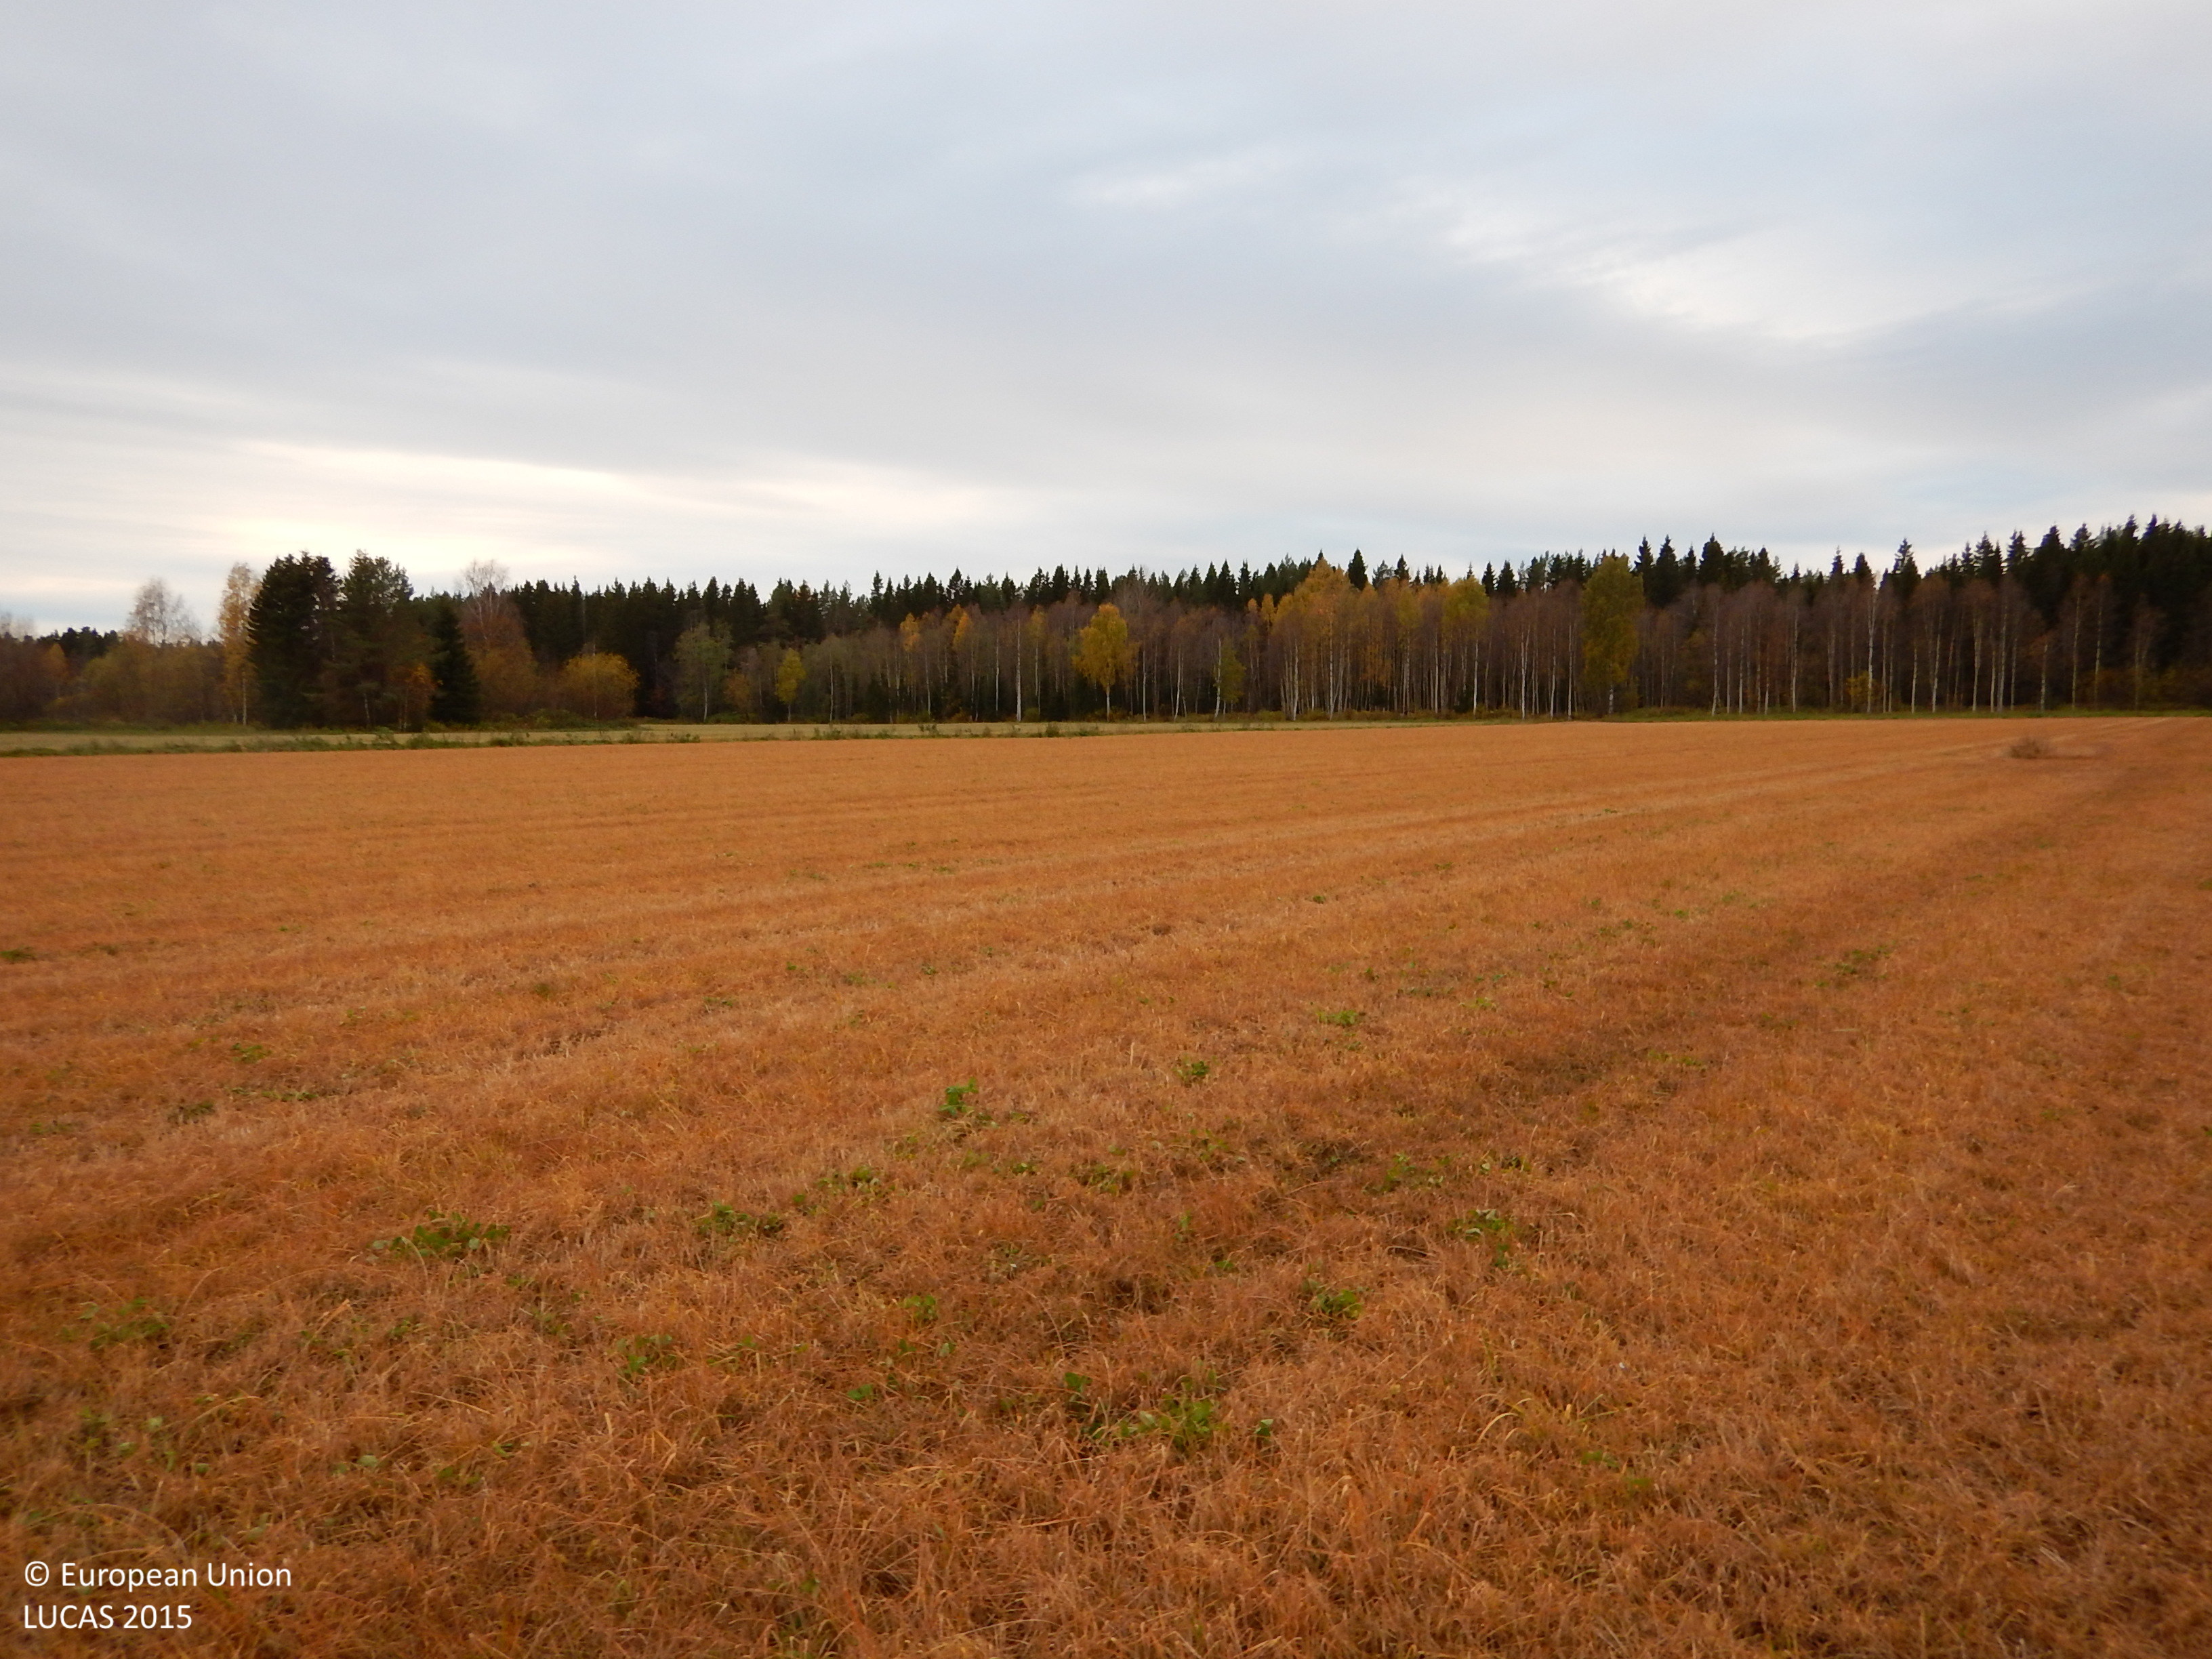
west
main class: Cropland
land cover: Temporary grasslands
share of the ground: > 75 %
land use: Agriculture (excluding fallow land and kitchen gardens)
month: October
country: SE
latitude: 64.8605
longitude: 20.9258
